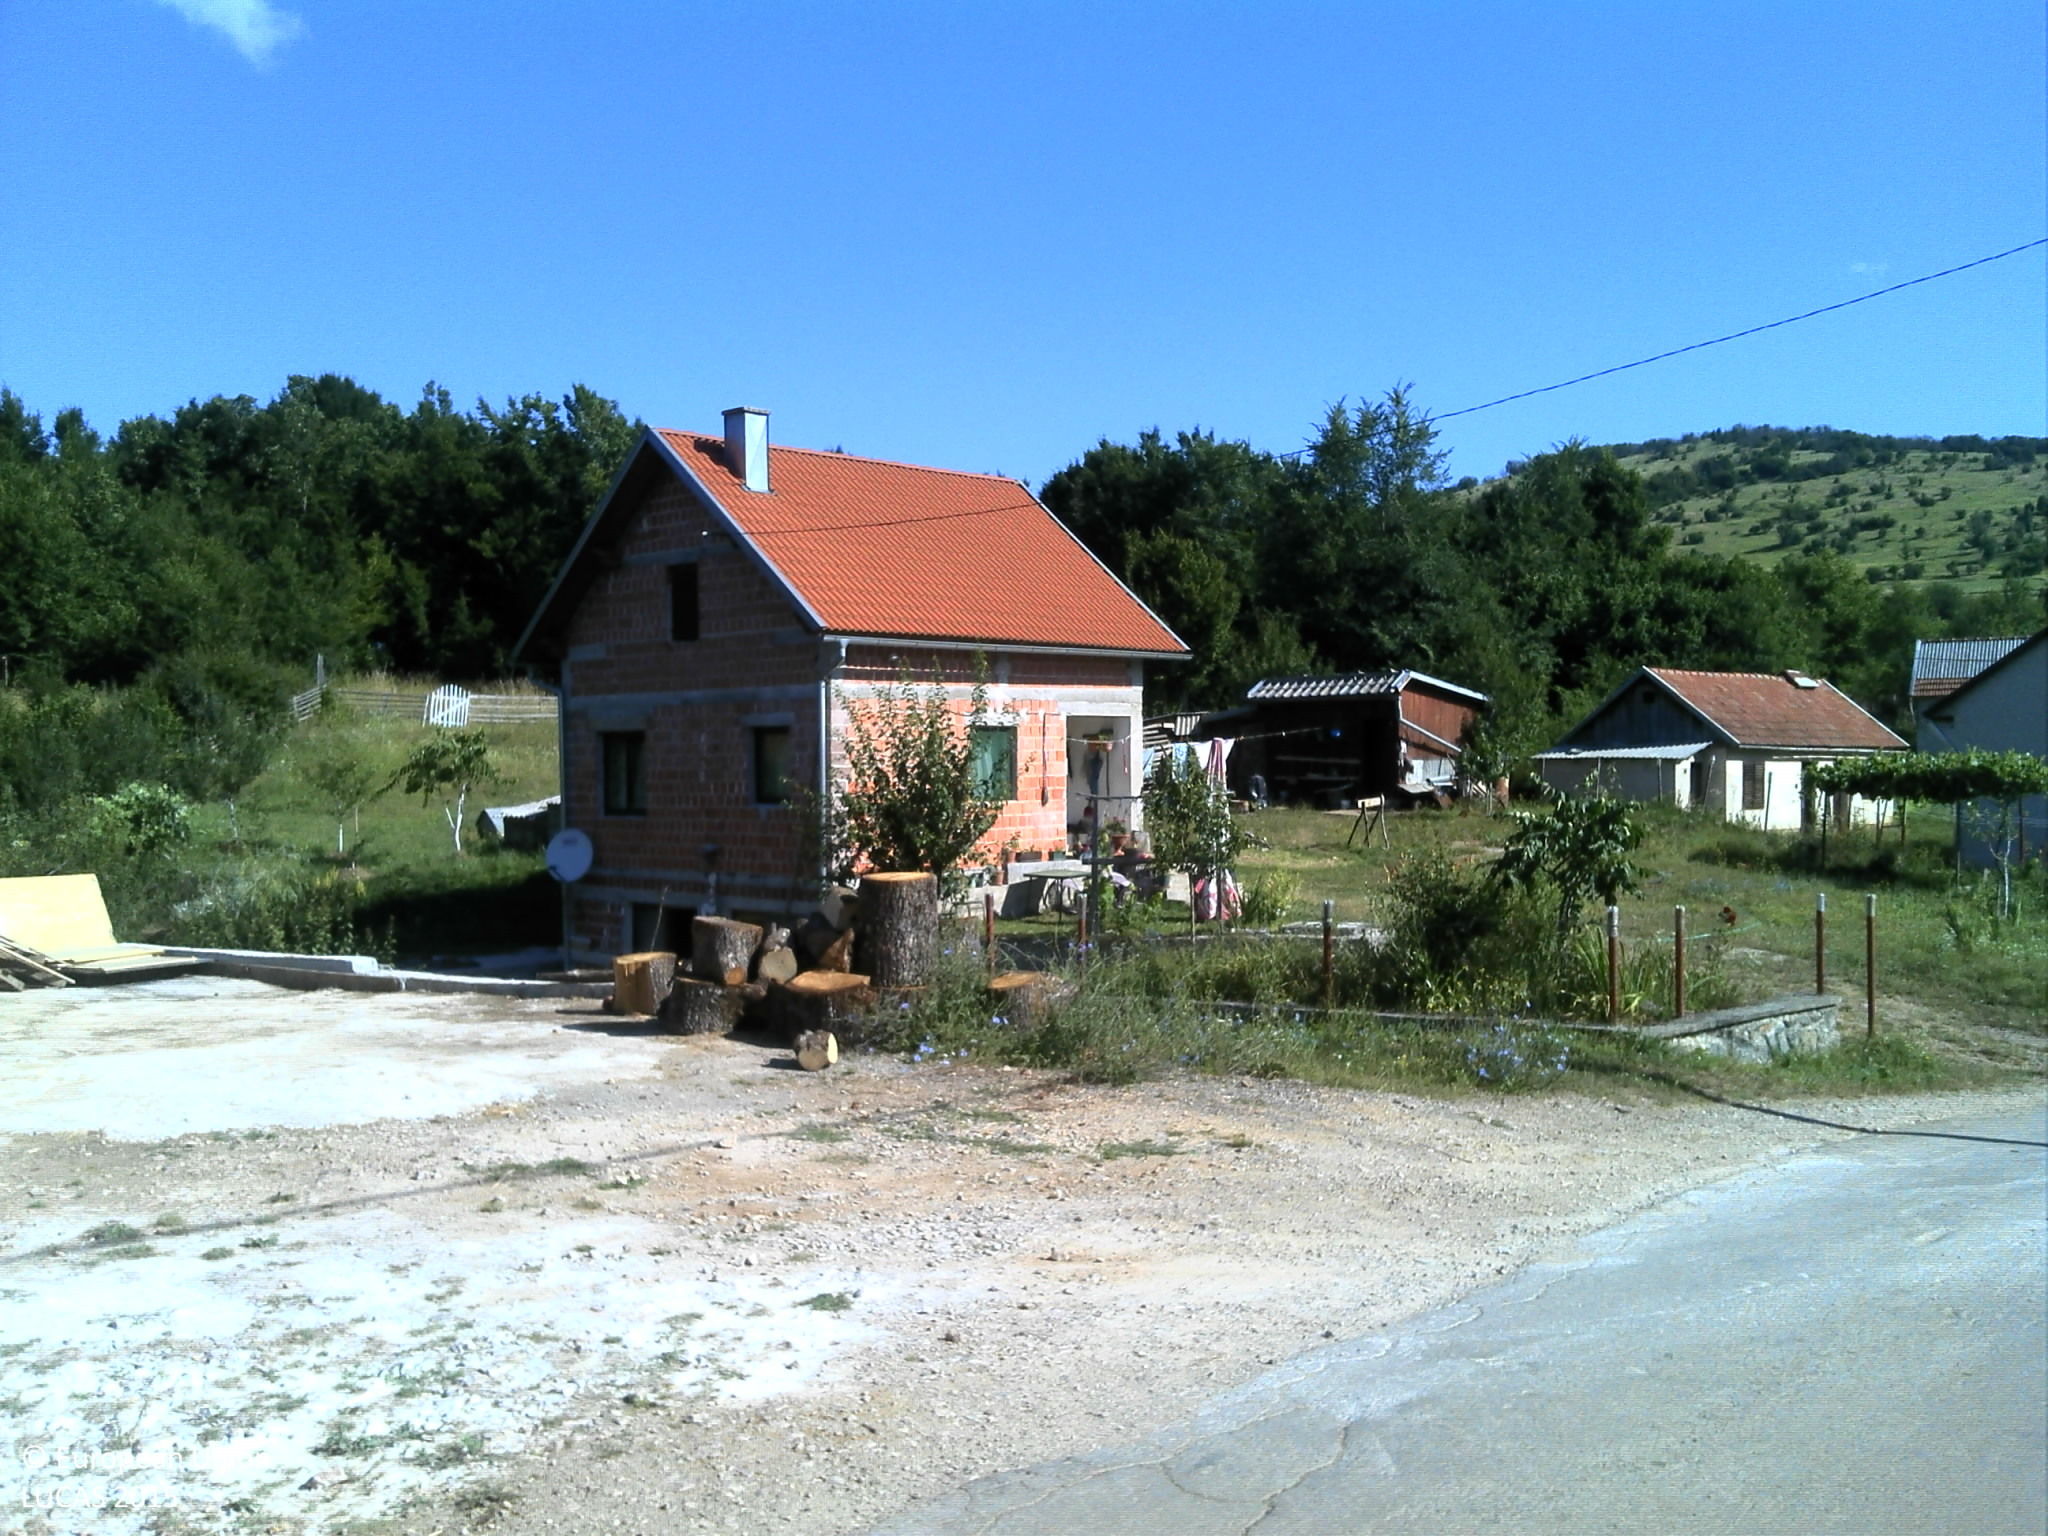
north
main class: Cropland
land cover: Other fruit trees and berries
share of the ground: 10 - 25 %
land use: Kitchen garden
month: July
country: HR
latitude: 44.8720
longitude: 15.1712
